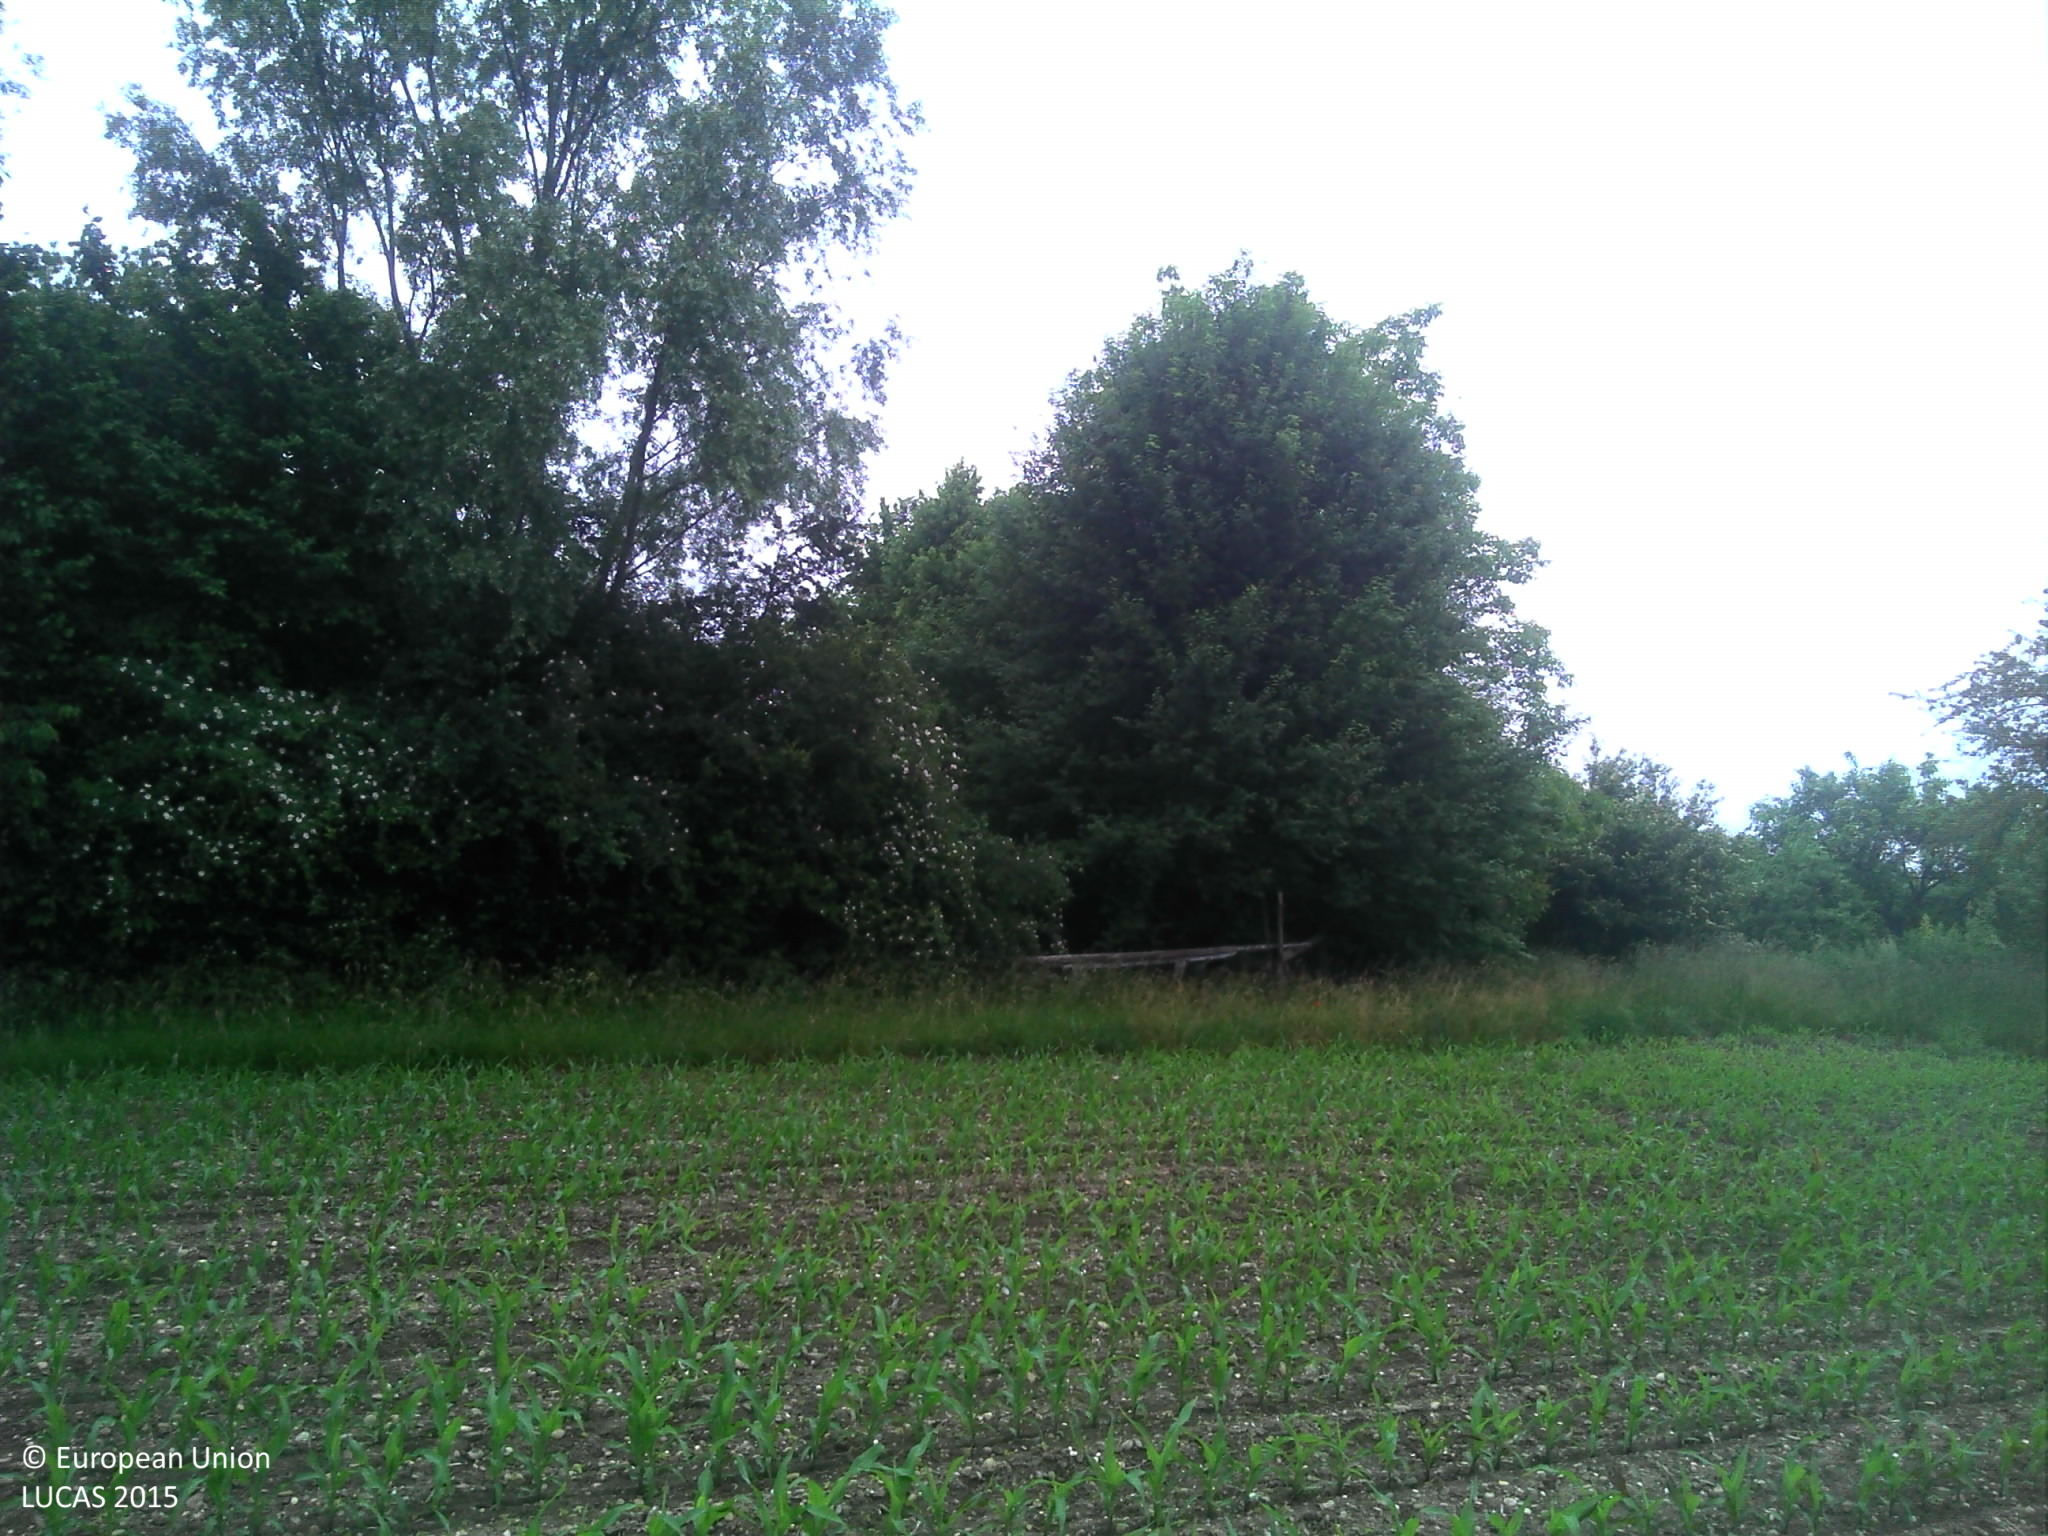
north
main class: Cropland
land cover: Maize
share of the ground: > 75 %
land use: Agriculture (excluding fallow land and kitchen gardens)
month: May
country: FR
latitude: 48.2692
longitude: 7.5894
